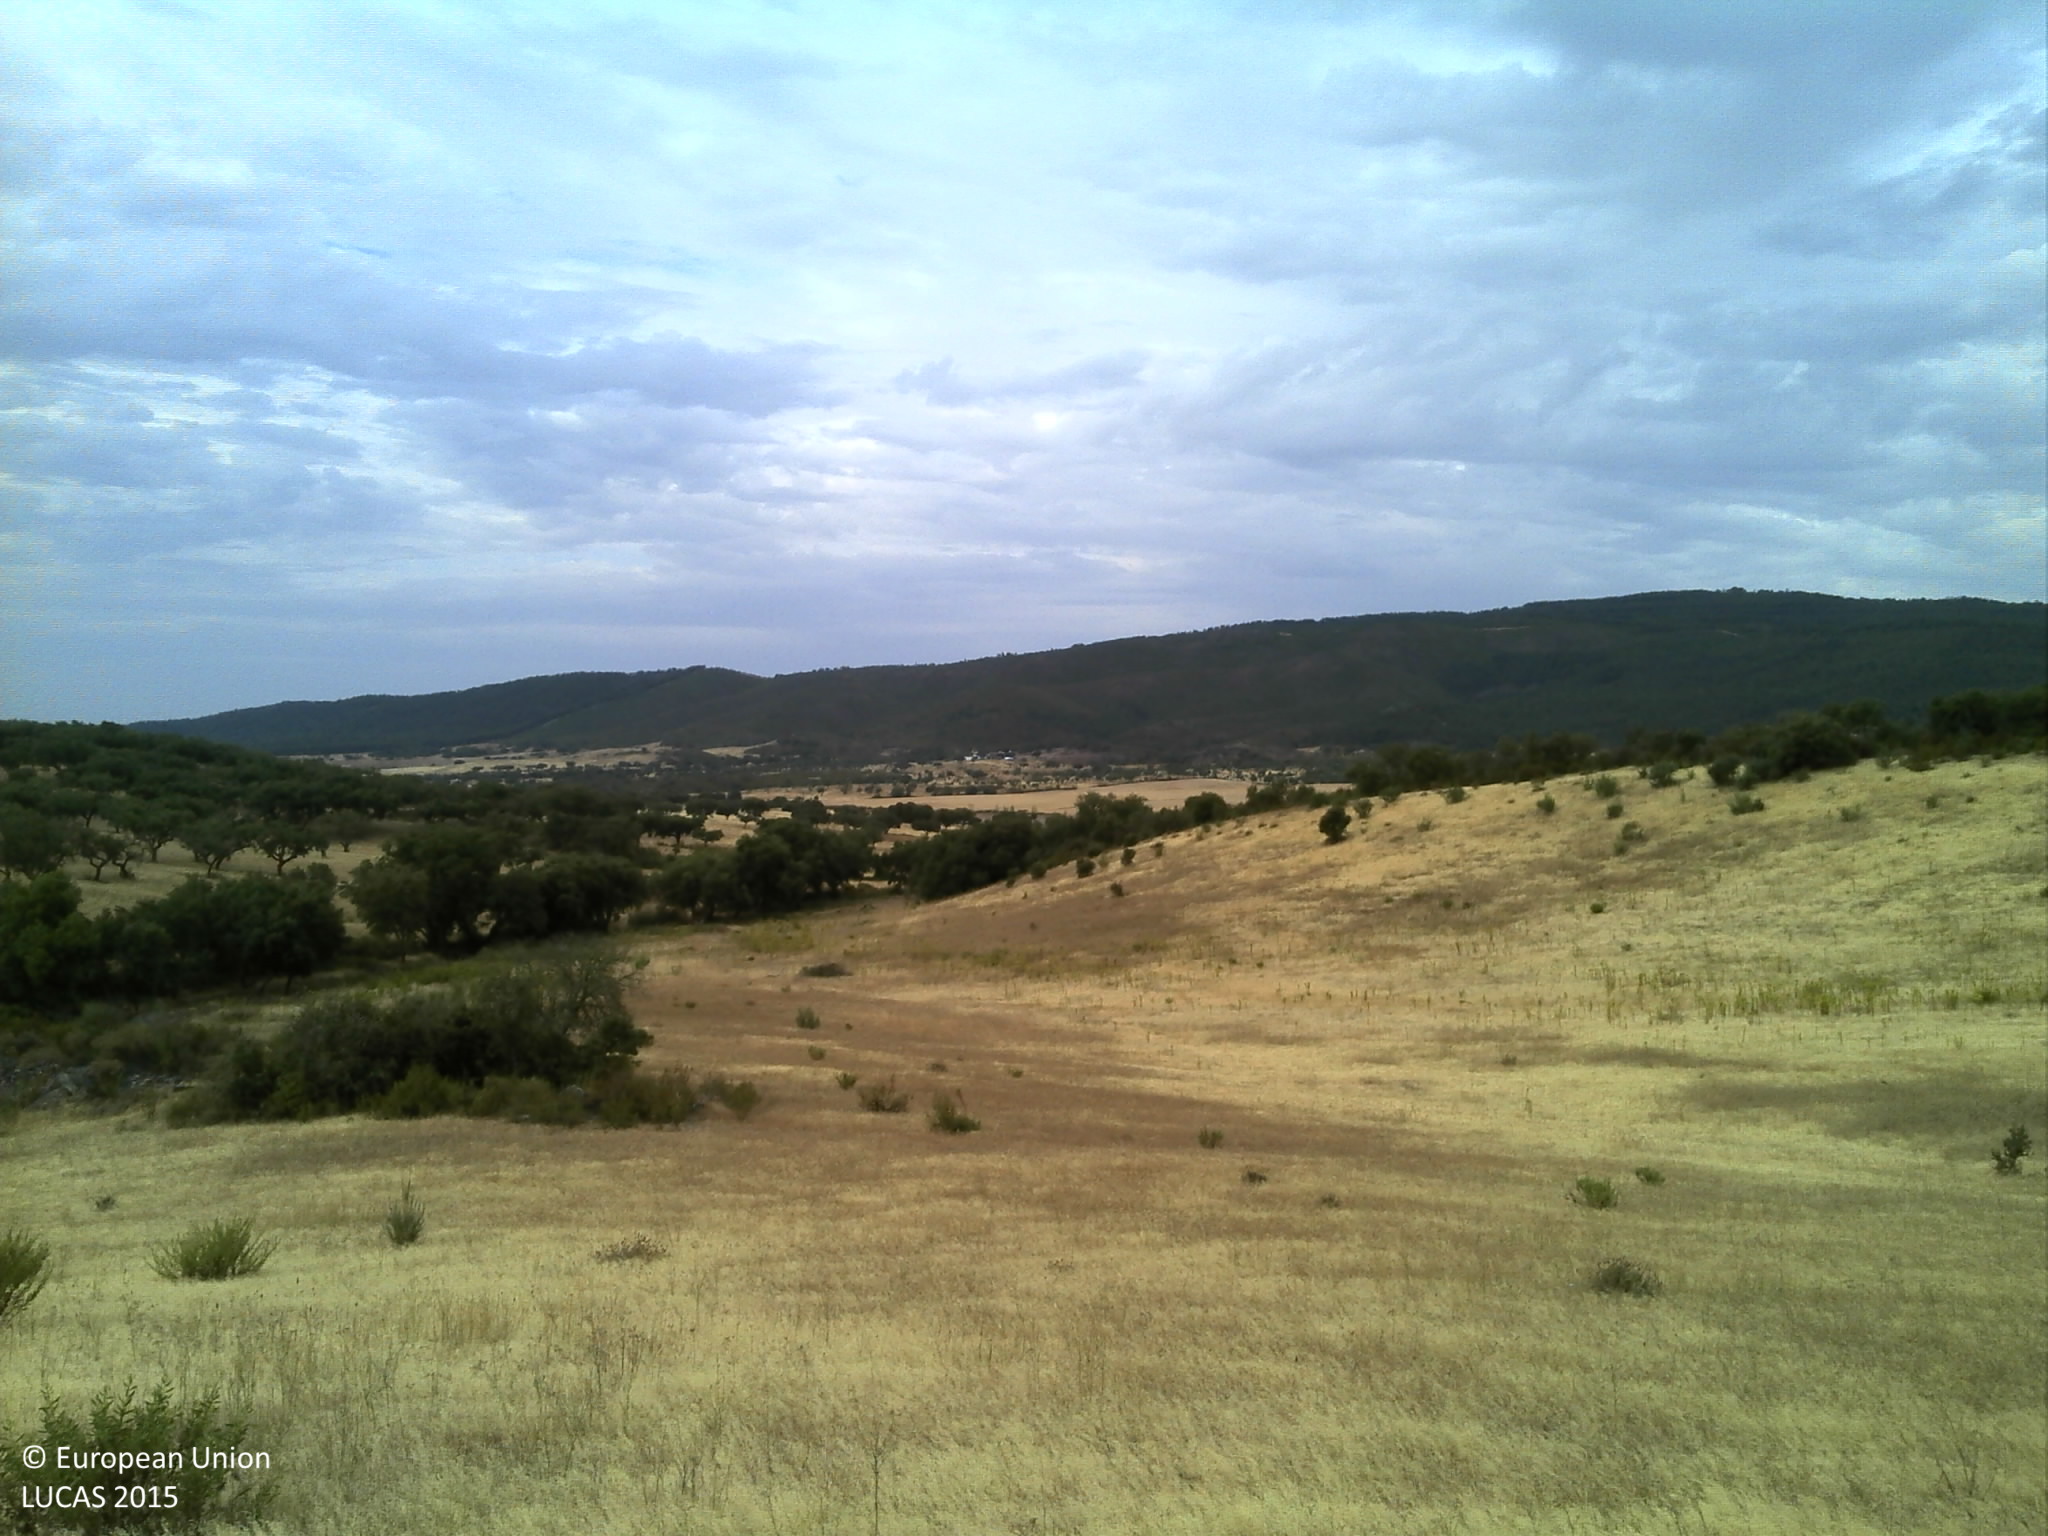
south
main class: Woodland
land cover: Broadleaved woodland
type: broadleaved evergreen forest
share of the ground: 10 - 25 %
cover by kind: herbaceous plants 40 %, broadleaved forest trees 25 %, shrubs 25 %, unconsolidated bare surface 10 %
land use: Forestry
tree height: > 5 m
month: July
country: PT
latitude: 38.7698
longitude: -7.5168
